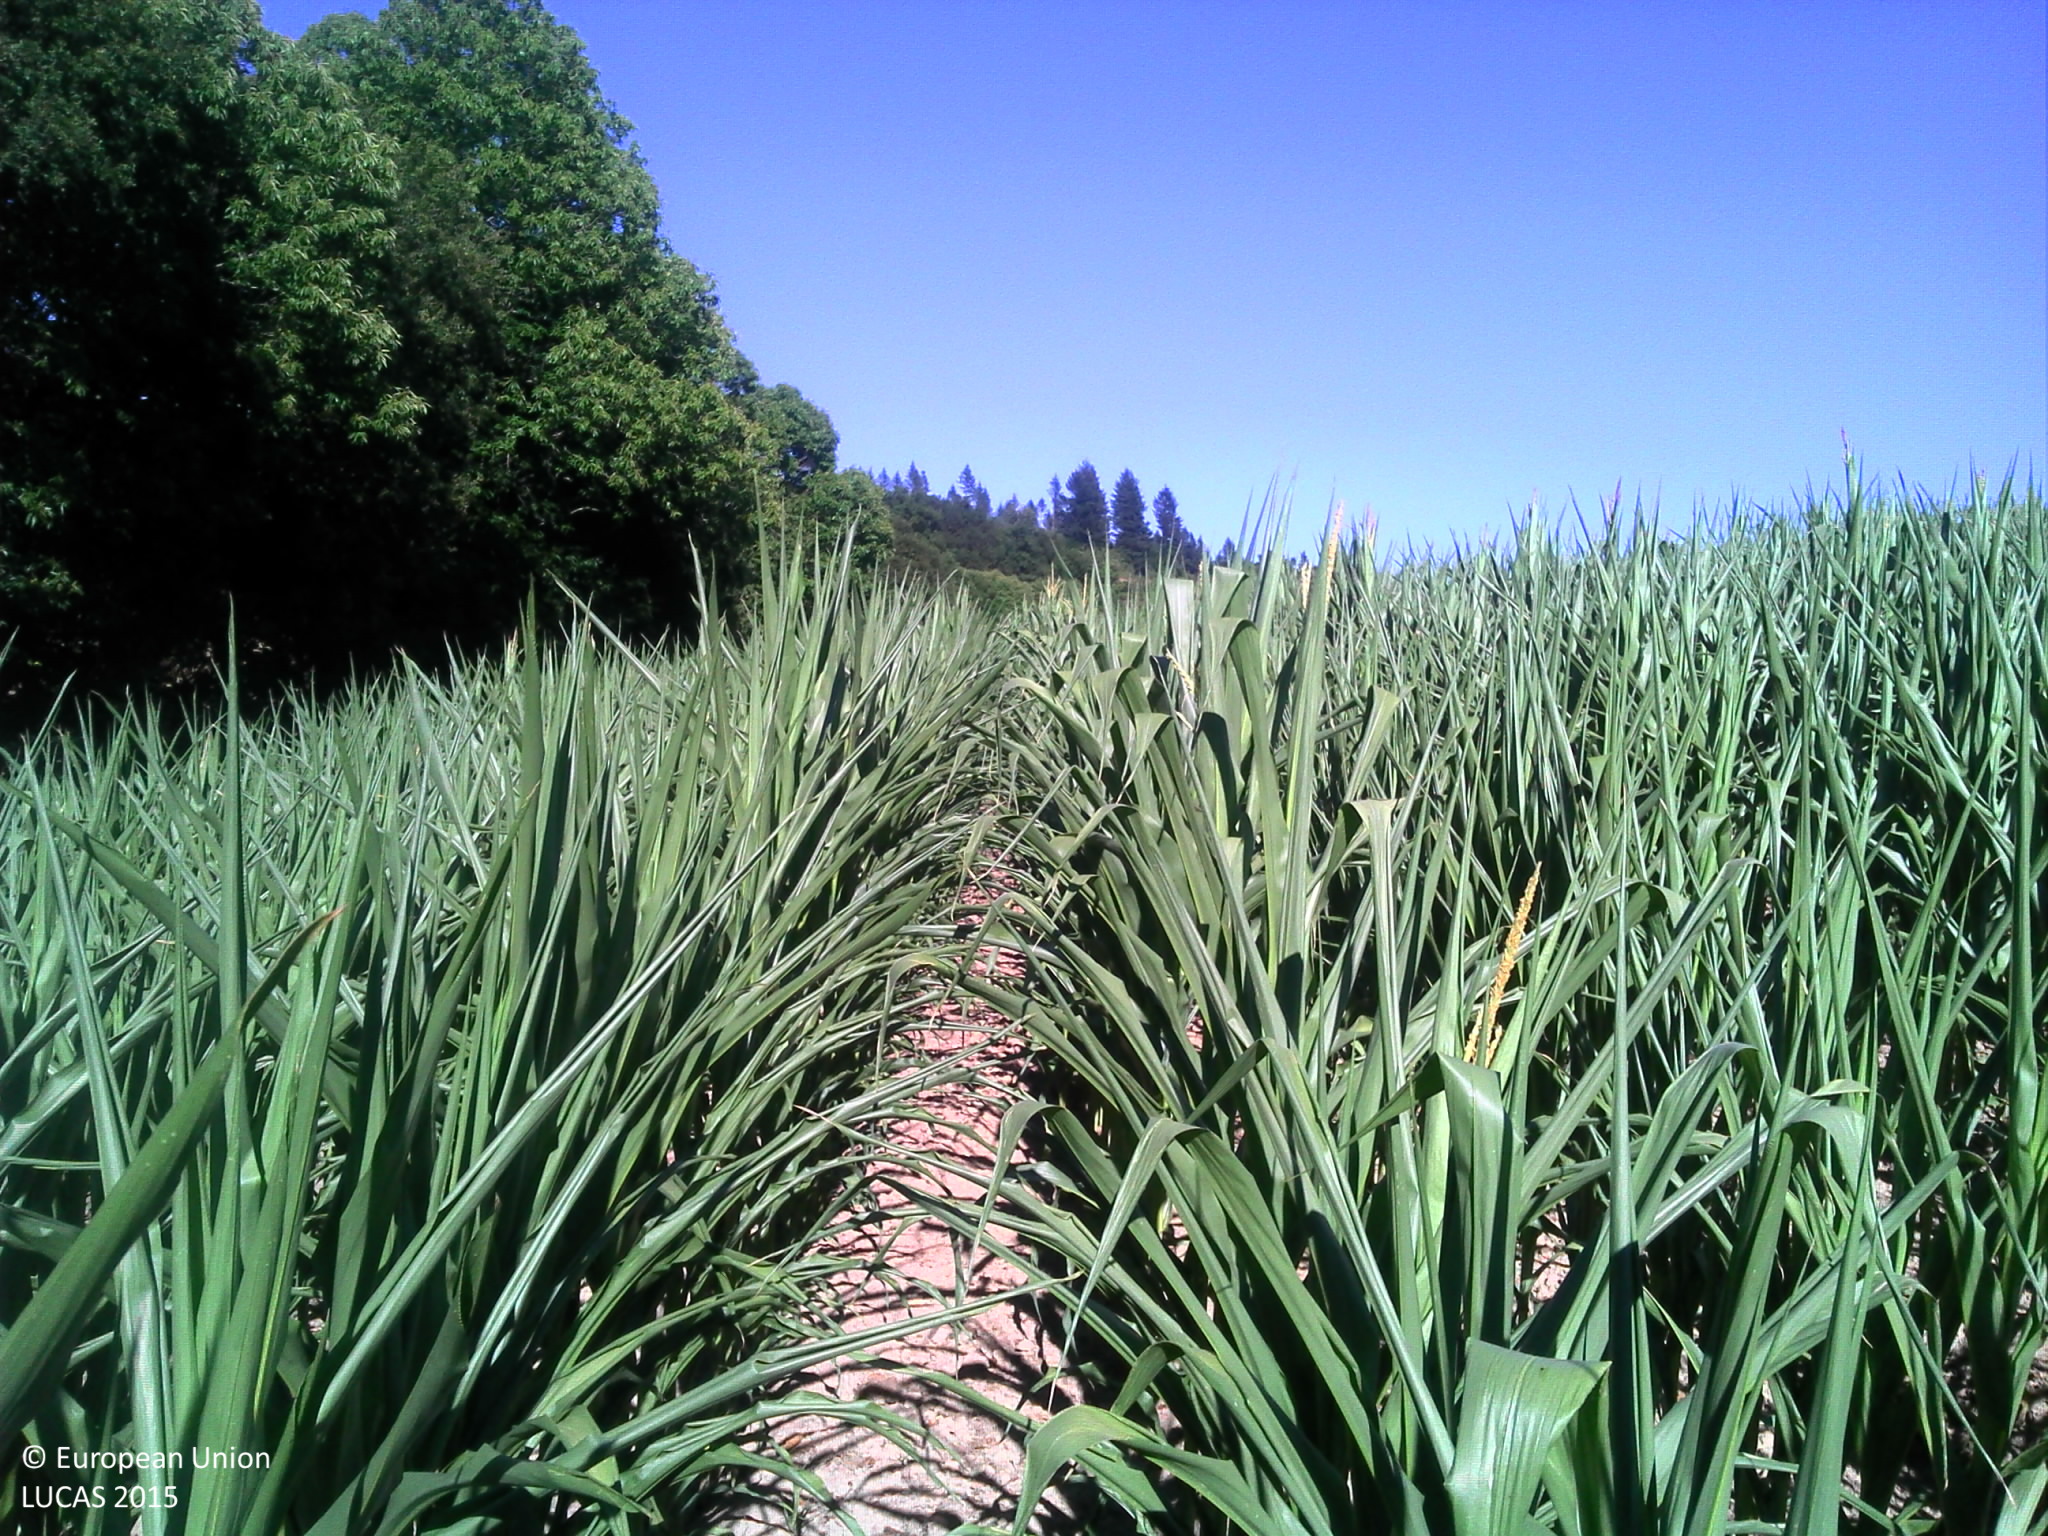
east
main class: Cropland
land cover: Maize
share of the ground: 25 - 50 %
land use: Agriculture (excluding fallow land and kitchen gardens)
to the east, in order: Maize; Fences; Tracks; Lines of trees; Grassland without tree/shrub cover; Fences; Abandoned hedges
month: July
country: FR
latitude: 45.5798
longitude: 1.7542
